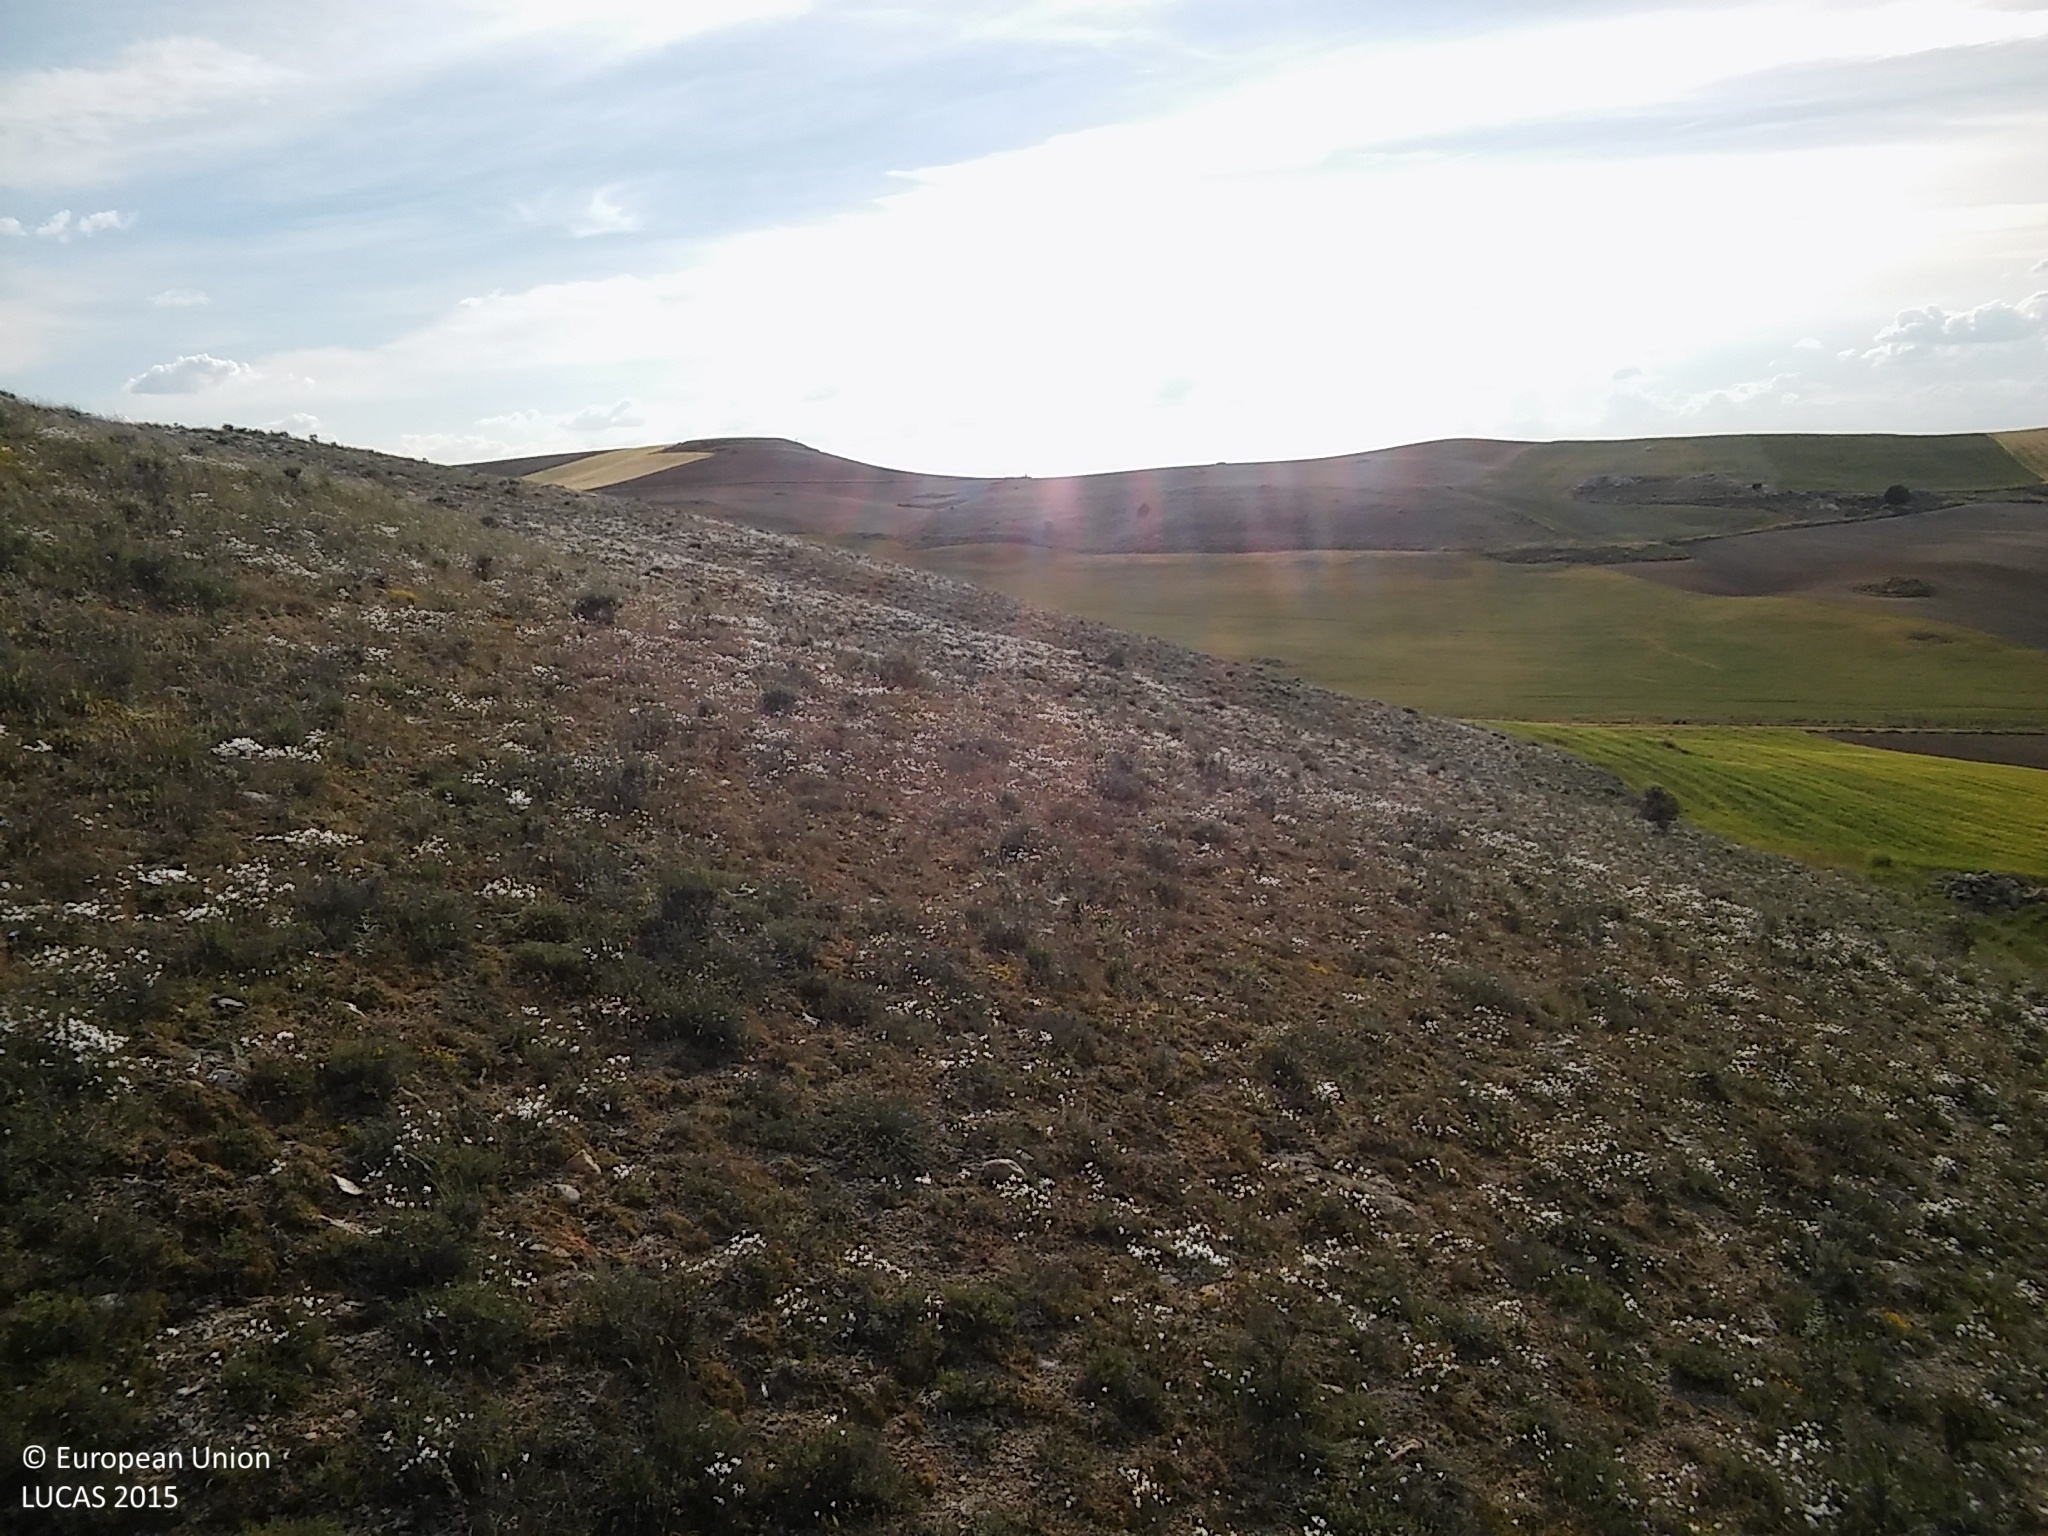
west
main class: Shrubland
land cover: Shrubland without tree cover
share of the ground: 25 - 50 %
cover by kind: shrubs 45 %, herbaceous plants 30 %, unconsolidated bare surface 25 %
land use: Semi-natural and natural areas not in use
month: June
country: ES
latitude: 41.5670
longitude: -3.7349
